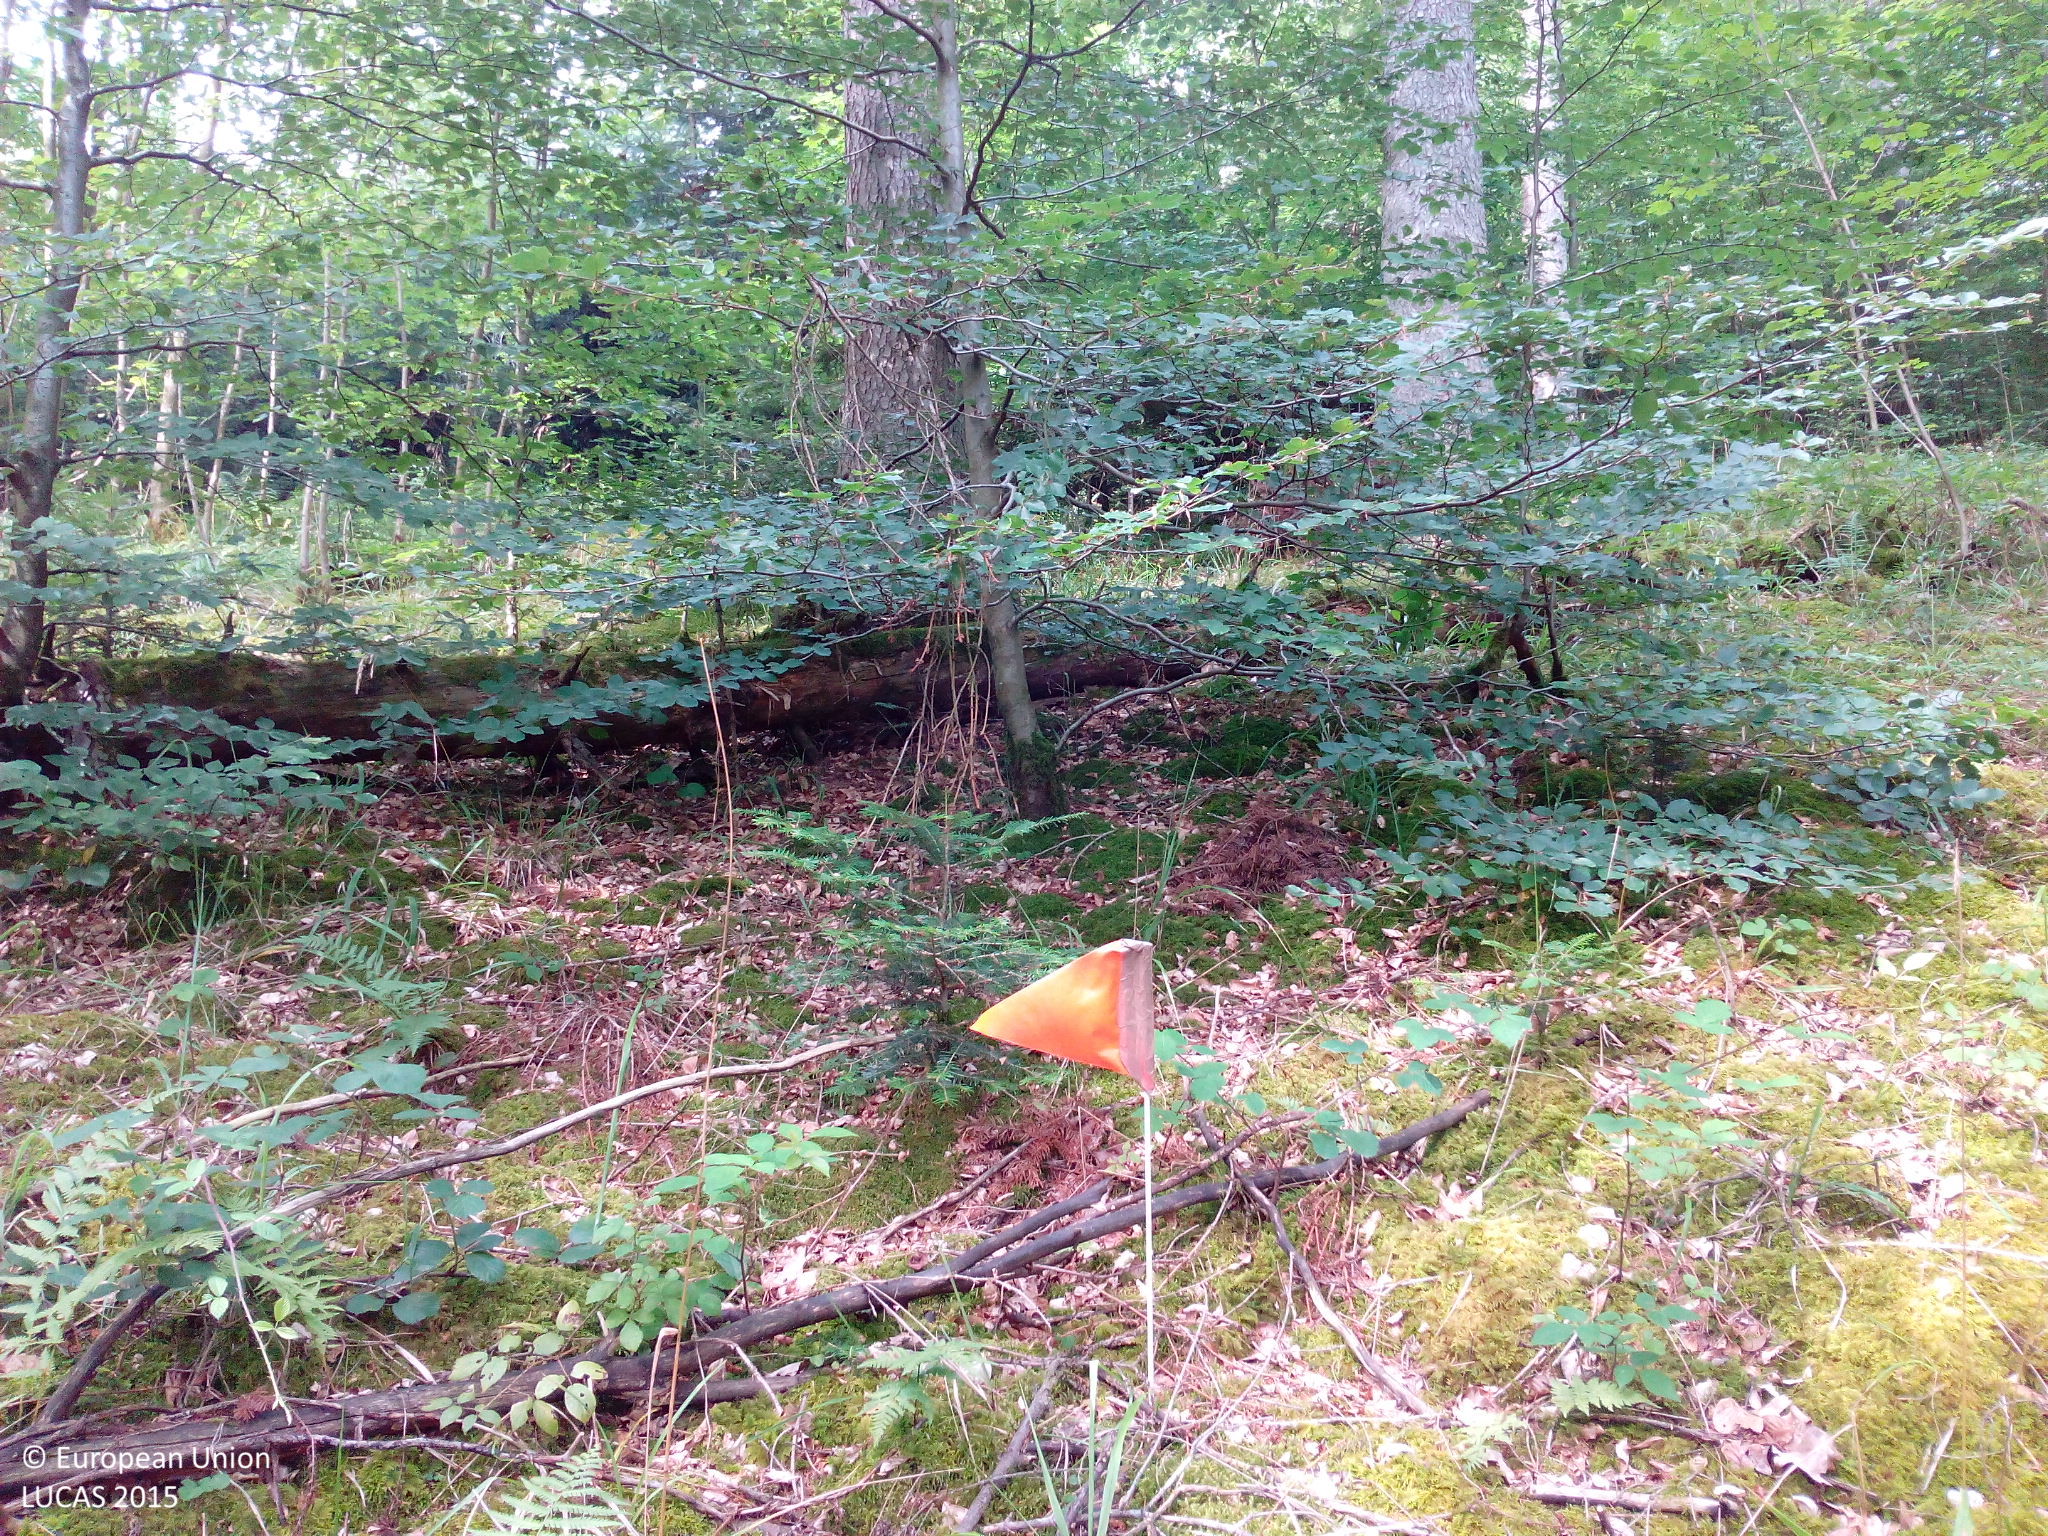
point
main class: Woodland
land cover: Other mixed woodland
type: hemiboreal forest and nemoral coniferous forest and mixed broadleaved-coniferous forest
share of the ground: > 75 %
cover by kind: coniferous forest trees 55 %, broadleaved forest trees 25 %, lichens and mosses 15 %, shrubs 5 %
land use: Forestry
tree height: > 5 m
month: July
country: DE
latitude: 49.0507
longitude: 9.6854
